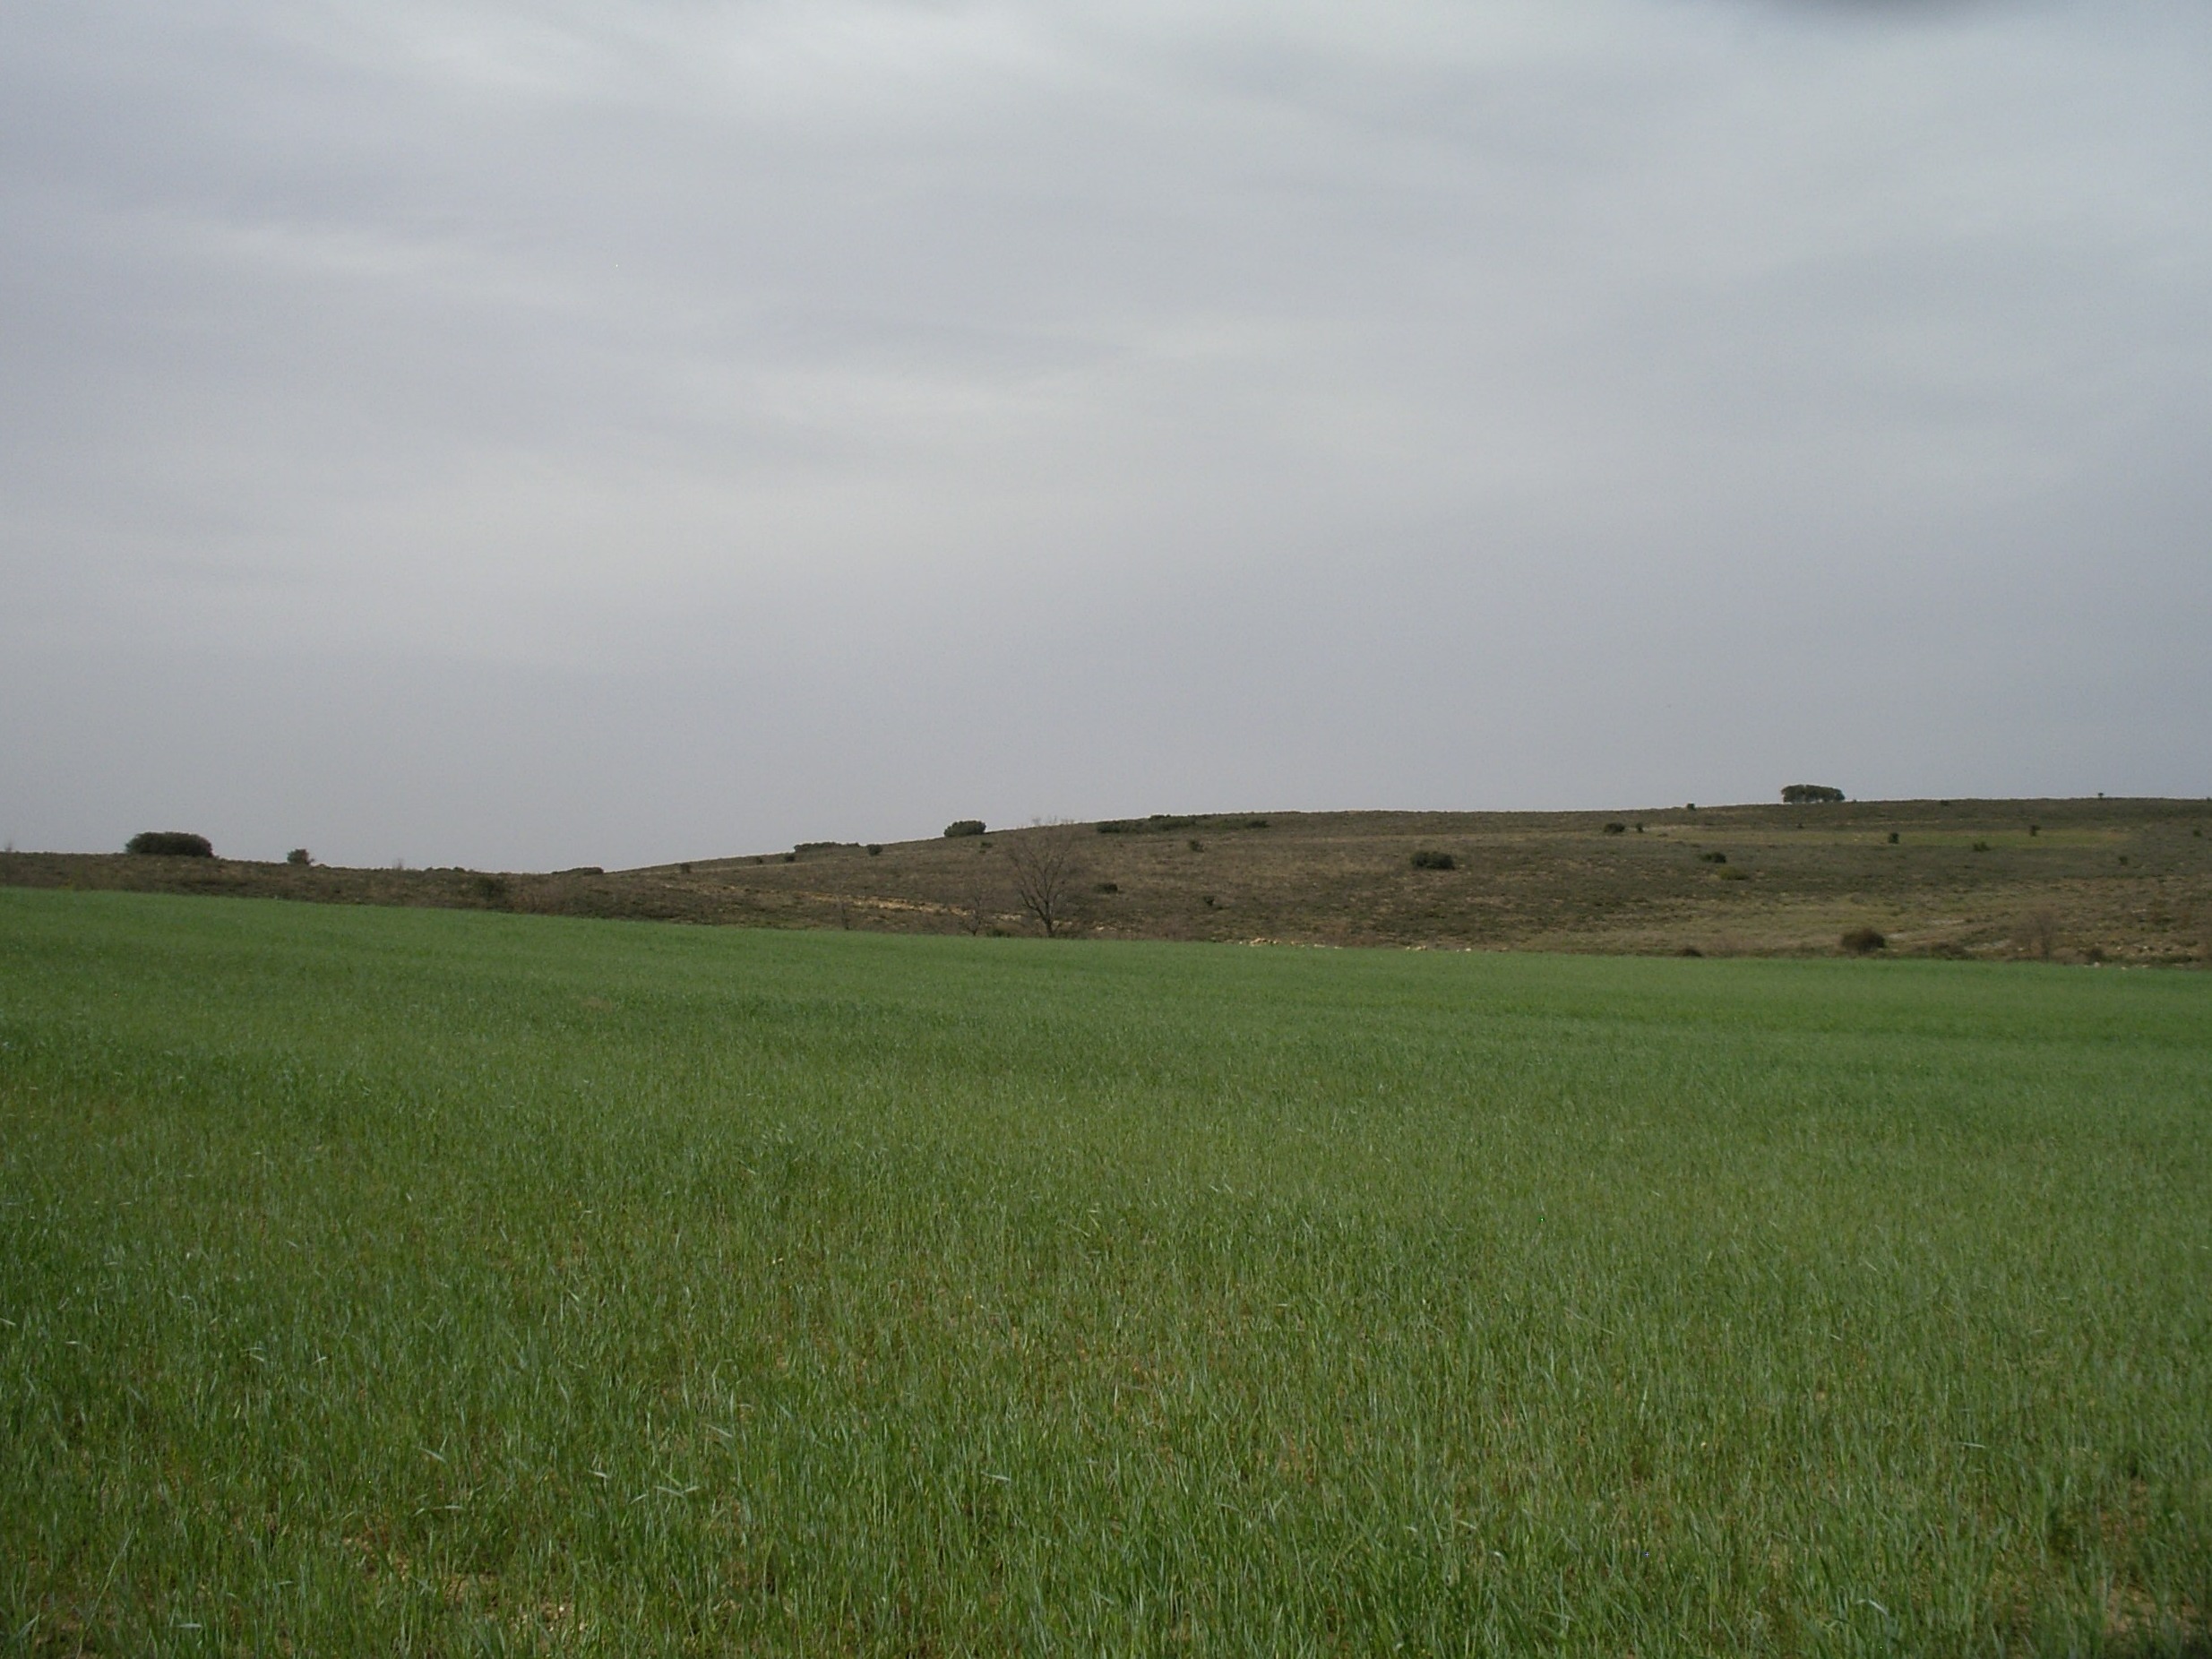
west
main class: Cropland
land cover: Barley
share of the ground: > 75 %
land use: Agriculture (excluding fallow land and kitchen gardens)
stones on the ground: 10 - 25 %
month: April
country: ES
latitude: 42.4338
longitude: -6.1408
